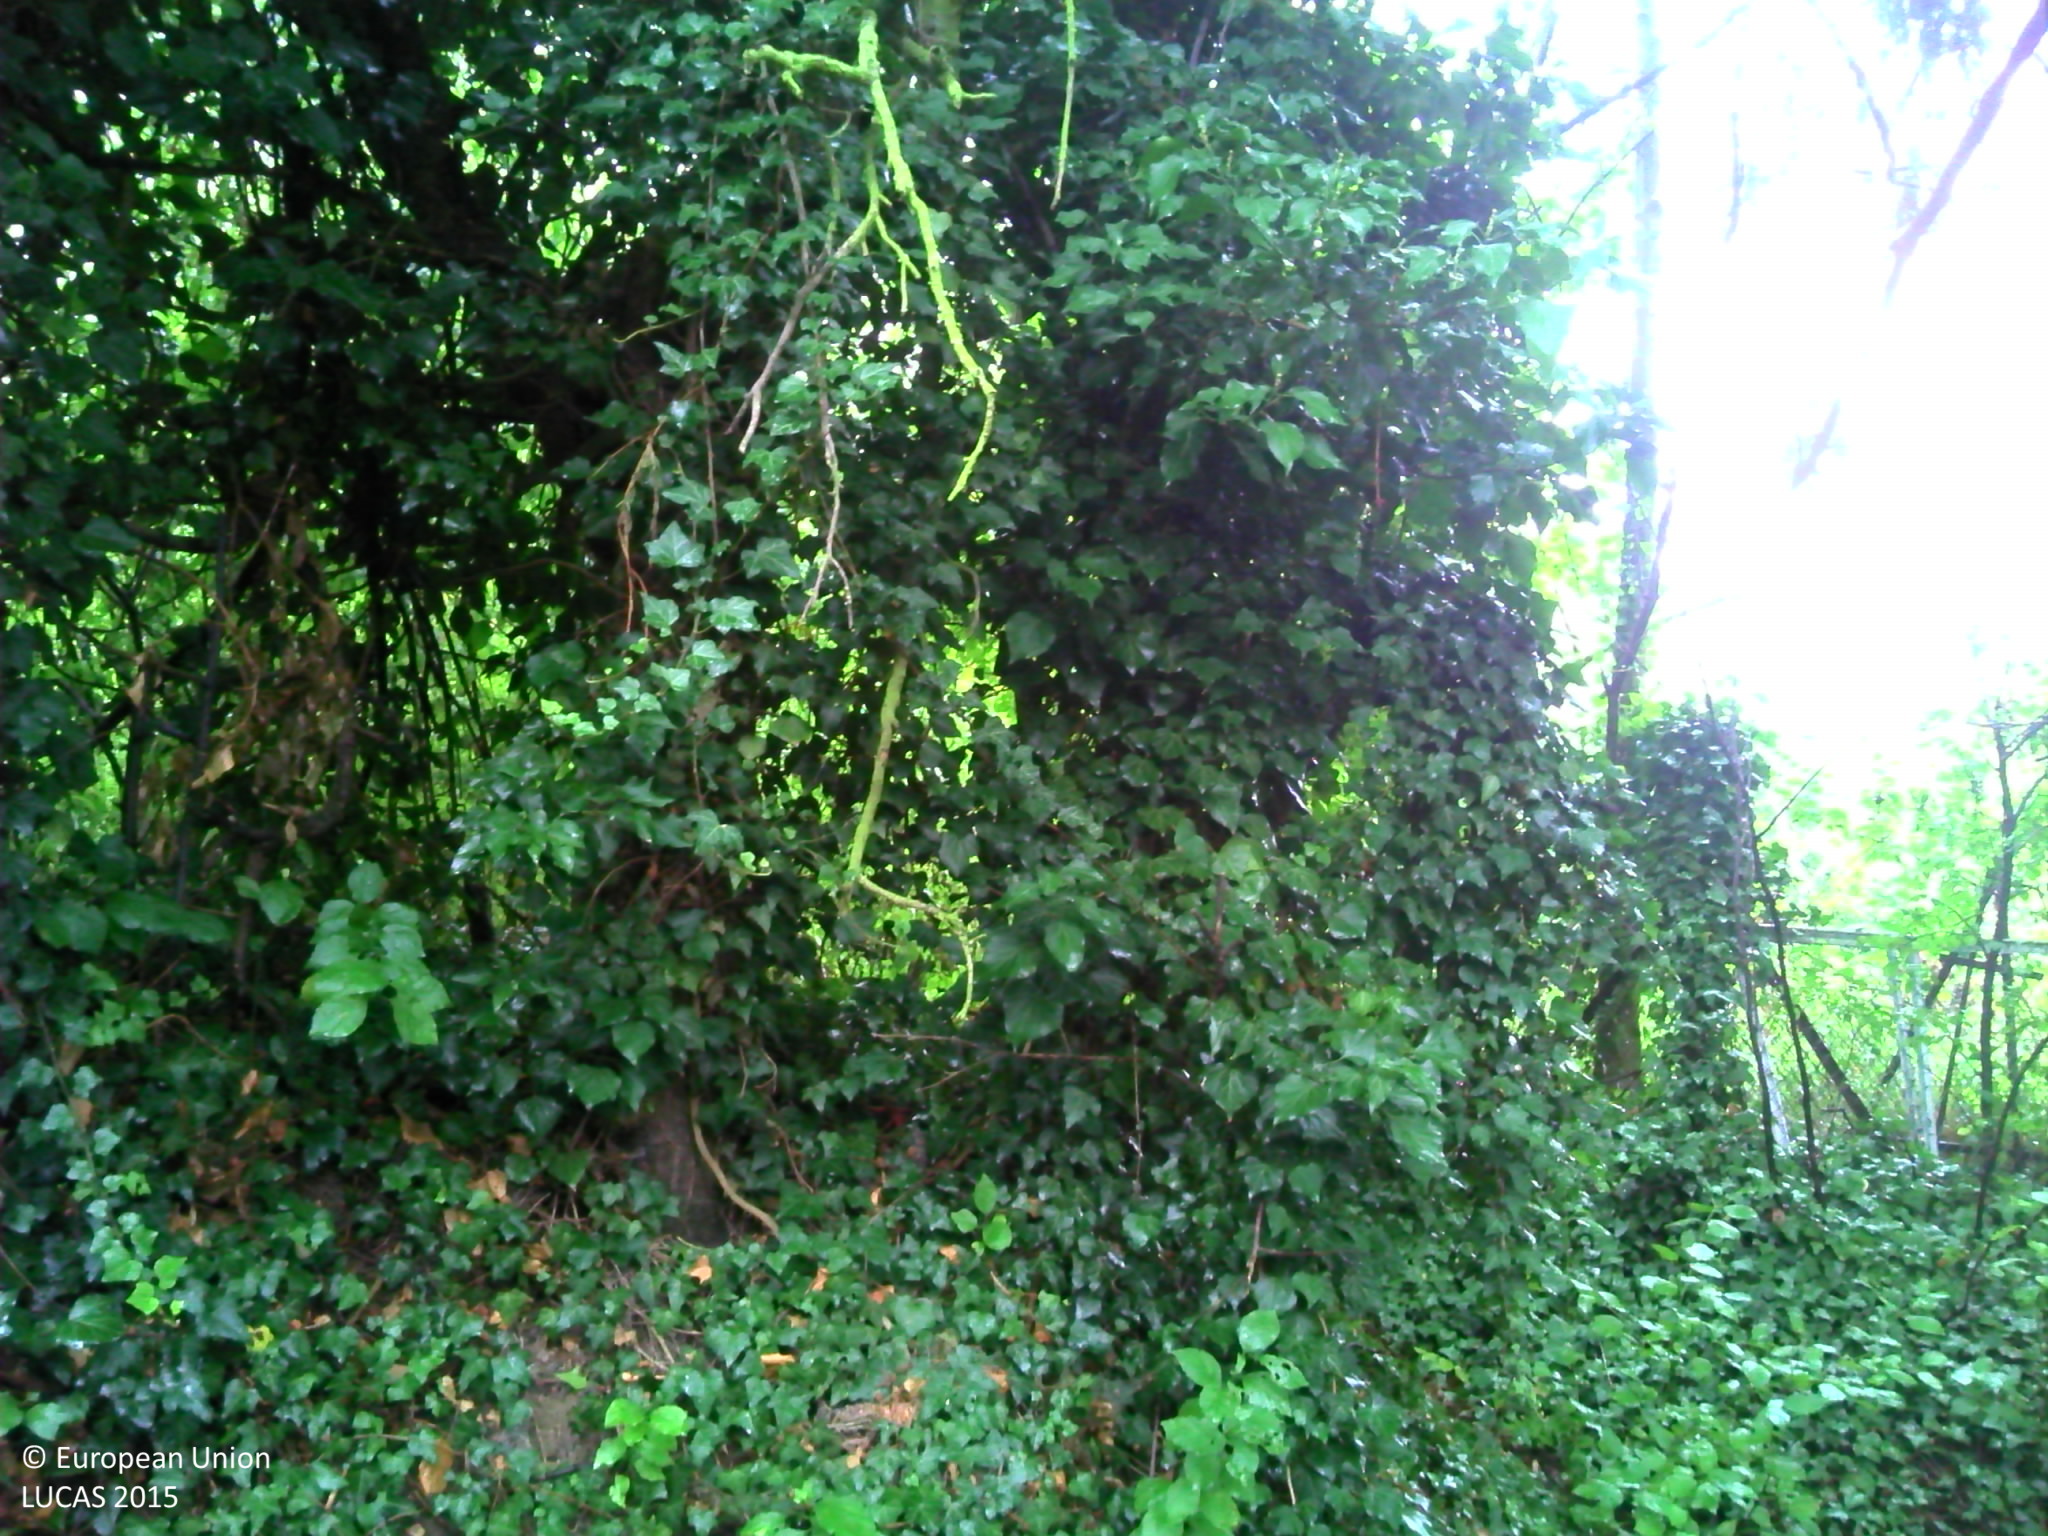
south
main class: Woodland
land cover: Broadleaved woodland
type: mesophytic deciduous forest
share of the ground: > 75 %
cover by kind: broadleaved forest trees 80 %, coniferous forest trees 15 %, herbaceous plants 5 %
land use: Forestry
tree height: > 5 m
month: August
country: FR
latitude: 47.7428
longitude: 7.4008
